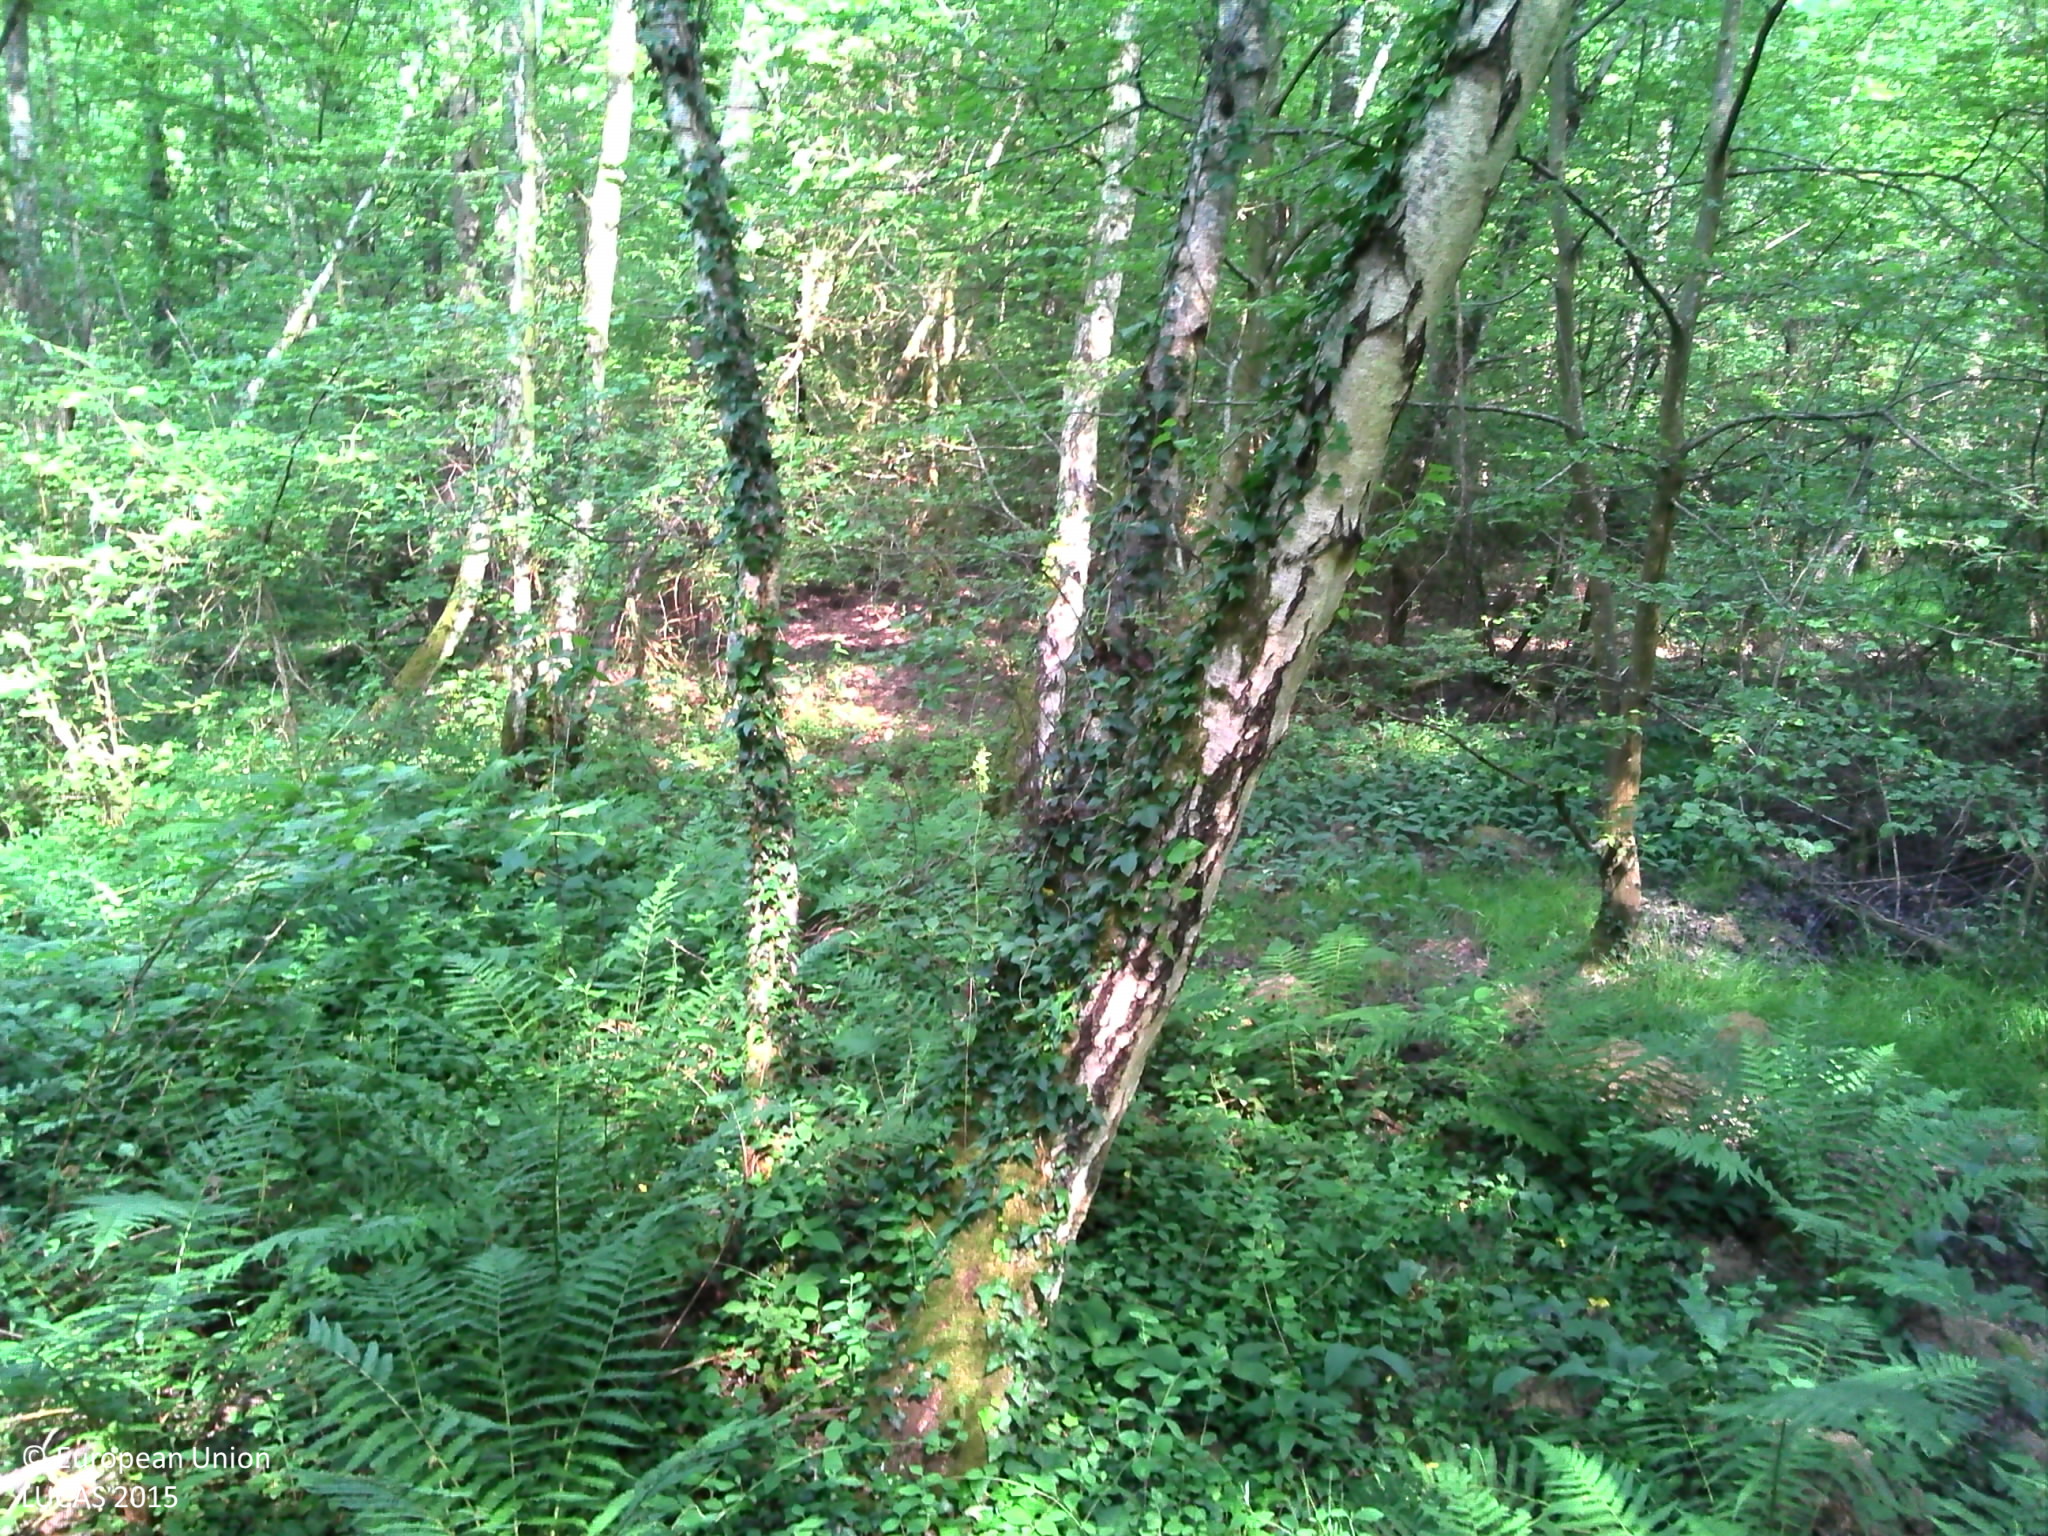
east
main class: Woodland
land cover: Broadleaved woodland
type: mesophytic deciduous forest
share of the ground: > 75 %
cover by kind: broadleaved forest trees 80 %, herbaceous plants 20 %
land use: Forestry
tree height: > 5 m
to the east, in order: Broadleaved woodland; Fences; Spontaneously vegetated surfaces; Fences; Grassland without tree/shrub cover; Fences; Grassland without tree/shrub cover; Fences; Lines of trees; Paved roads, cycling and walking lanes; Lines of trees; Tracks; Grassland without tree/shrub cover
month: June
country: FR
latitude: 45.9245
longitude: 4.9356
